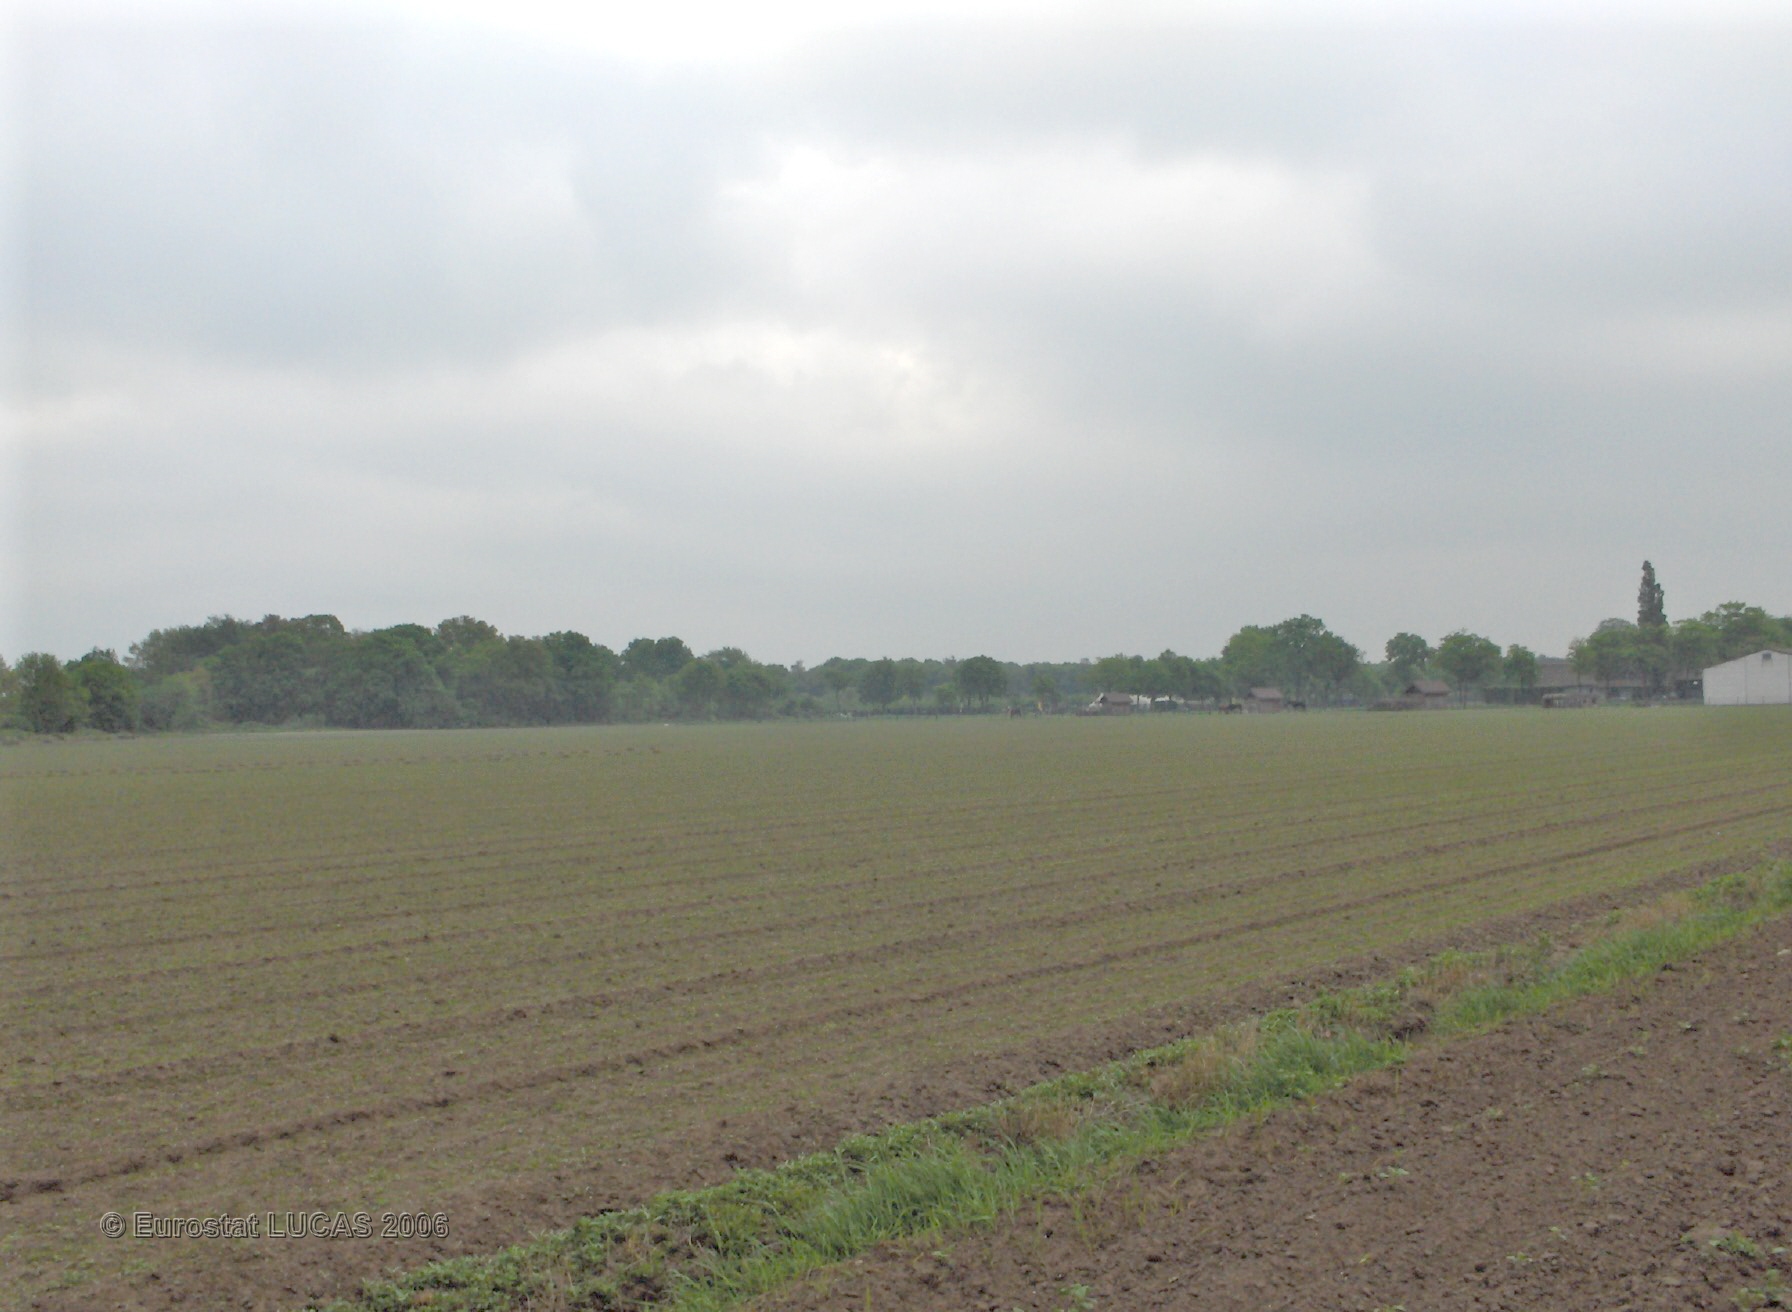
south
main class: Bare land
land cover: Bare land
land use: Agriculture (excluding fallow land and kitchen gardens)
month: May
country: BE
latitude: 51.3435
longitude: 4.3821
